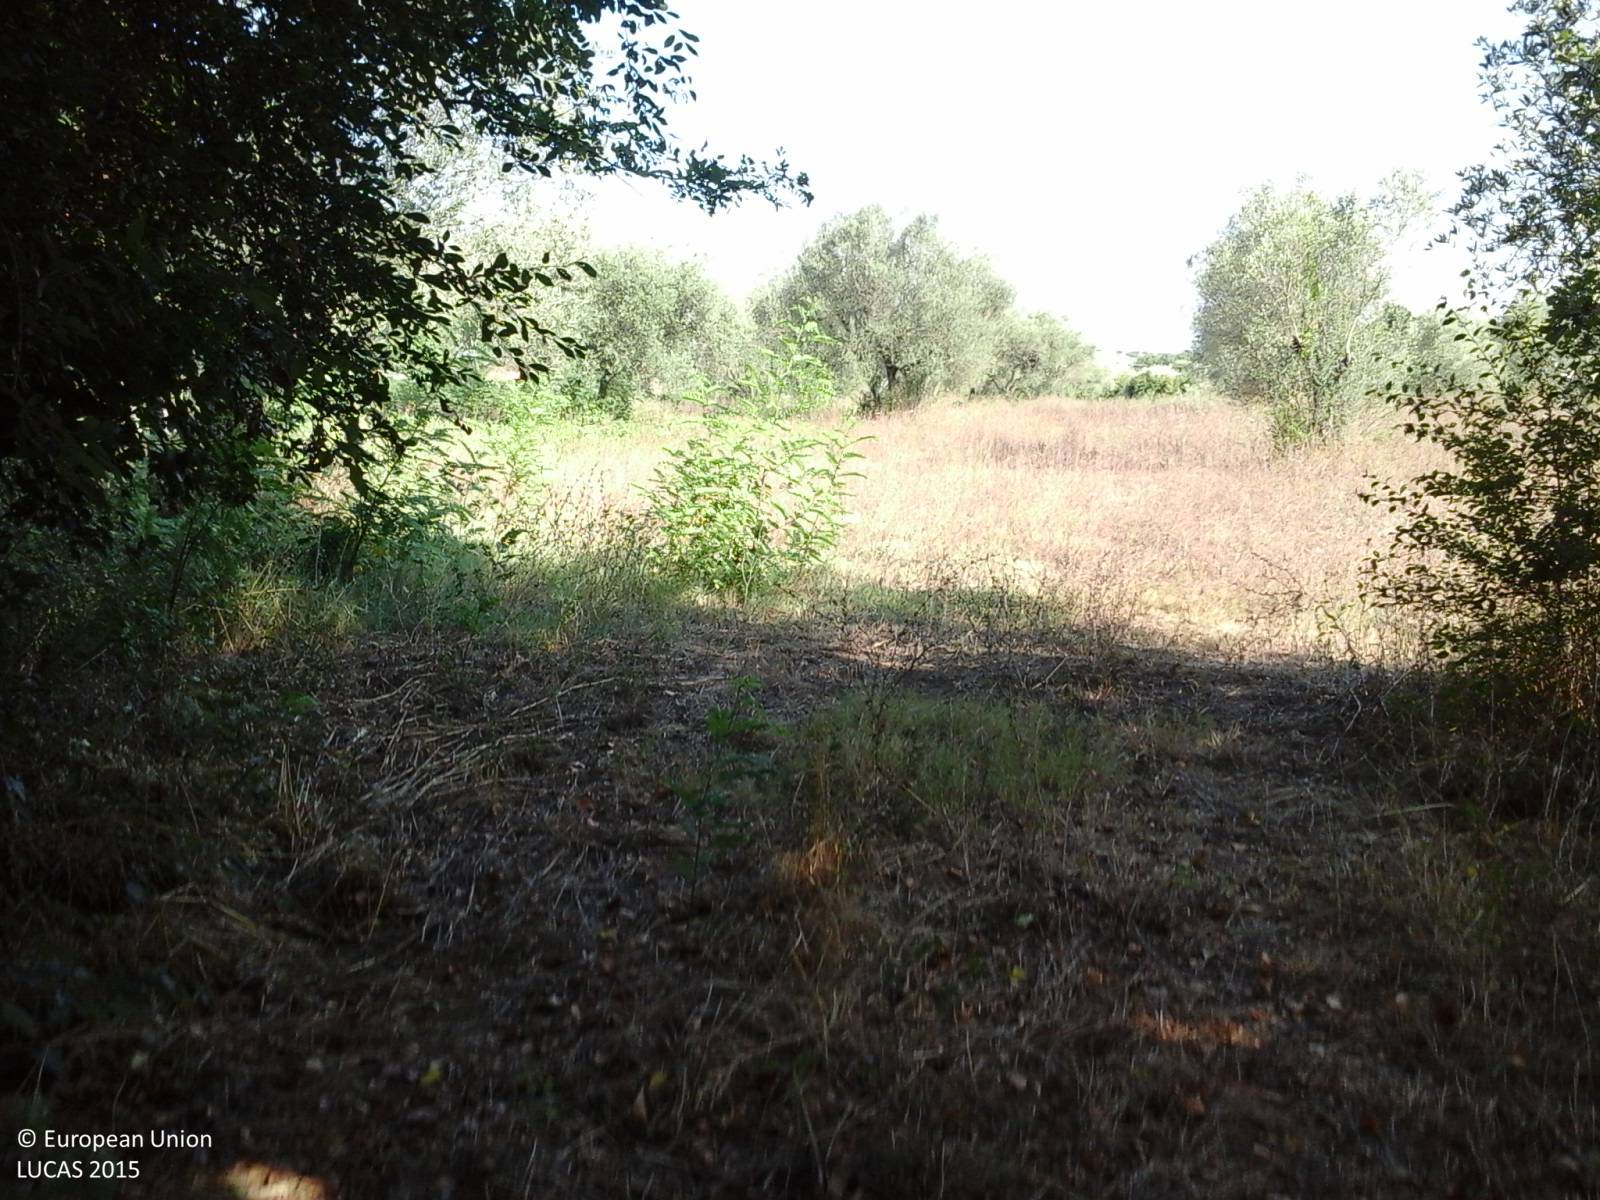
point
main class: Cropland
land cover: Olive groves
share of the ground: > 75 %
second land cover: Spontaneously vegetated surfaces
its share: > 75 %
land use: Agriculture (excluding fallow land and kitchen gardens)
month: August
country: IT
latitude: 42.1266
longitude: 12.0852
